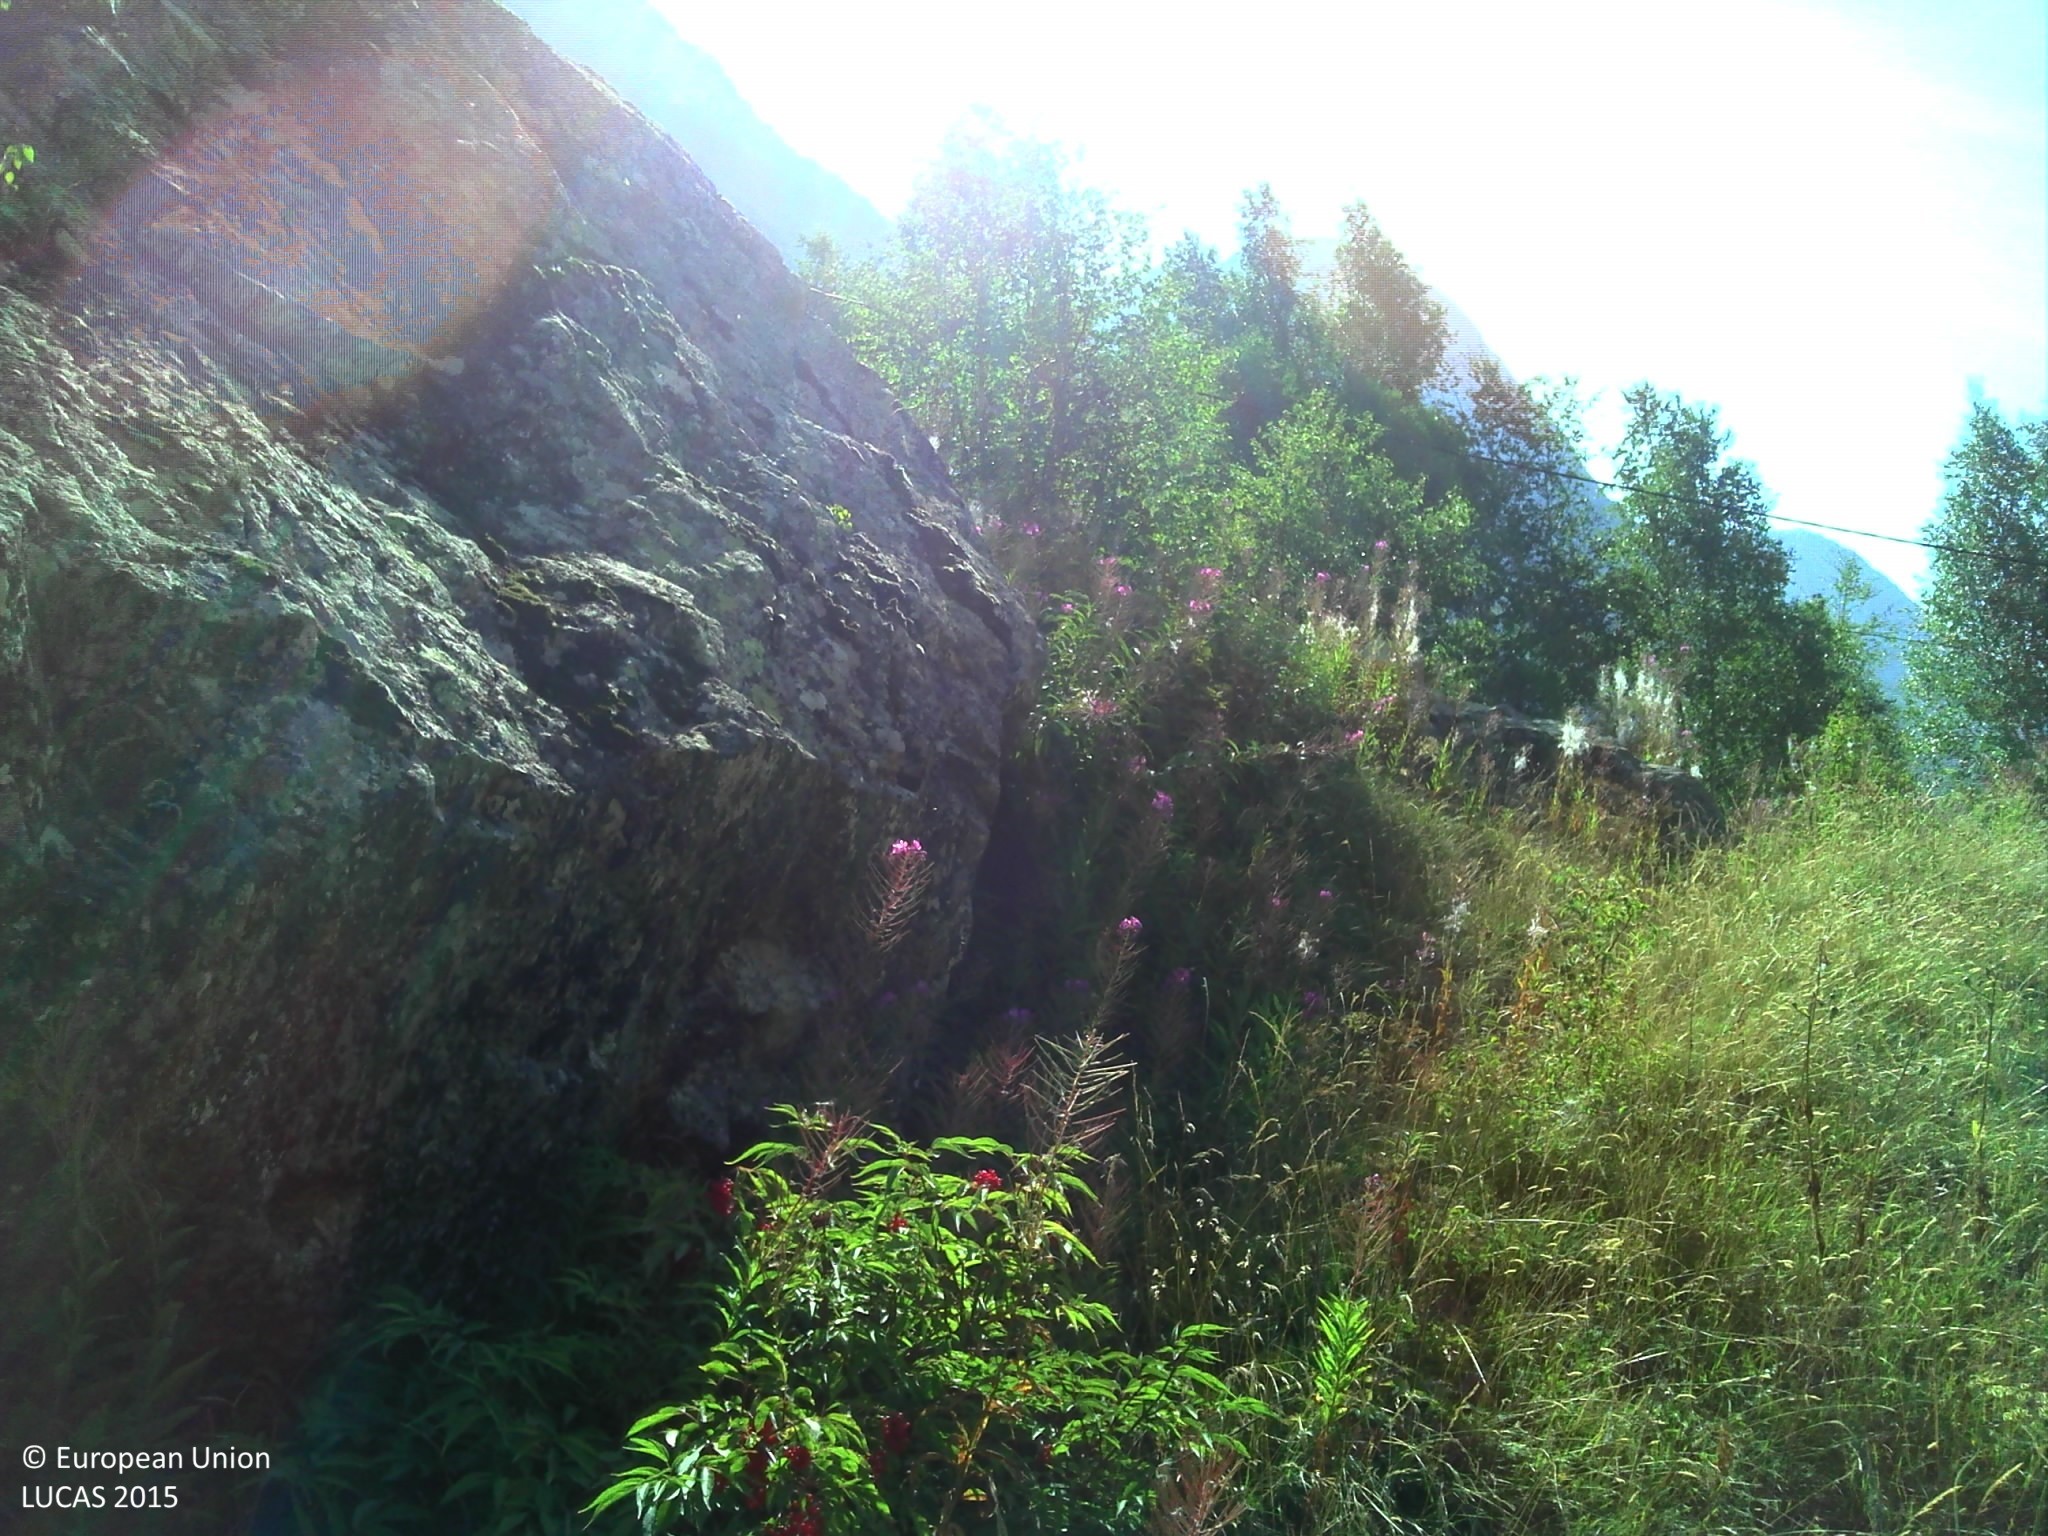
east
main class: Grassland
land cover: Grassland without tree/shrub cover
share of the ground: > 75 %
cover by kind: herbaceous plants 90 %, shrubs 5 %, unconsolidated bare surface 5 %
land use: Semi-natural and natural areas not in use
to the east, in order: Grassland without tree/shrub cover; Rocks and stones; Grassland with sparse tree/shrub cover; Electric lines; Tracks; Grassland with sparse tree/shrub cover; Rocks and stones; Broadleaved woodland; Grassland with sparse tree/shrub cover; Rocks and stones; Tracks; Other mixed woodland
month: August
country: FR
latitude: 44.9342
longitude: 6.2930
